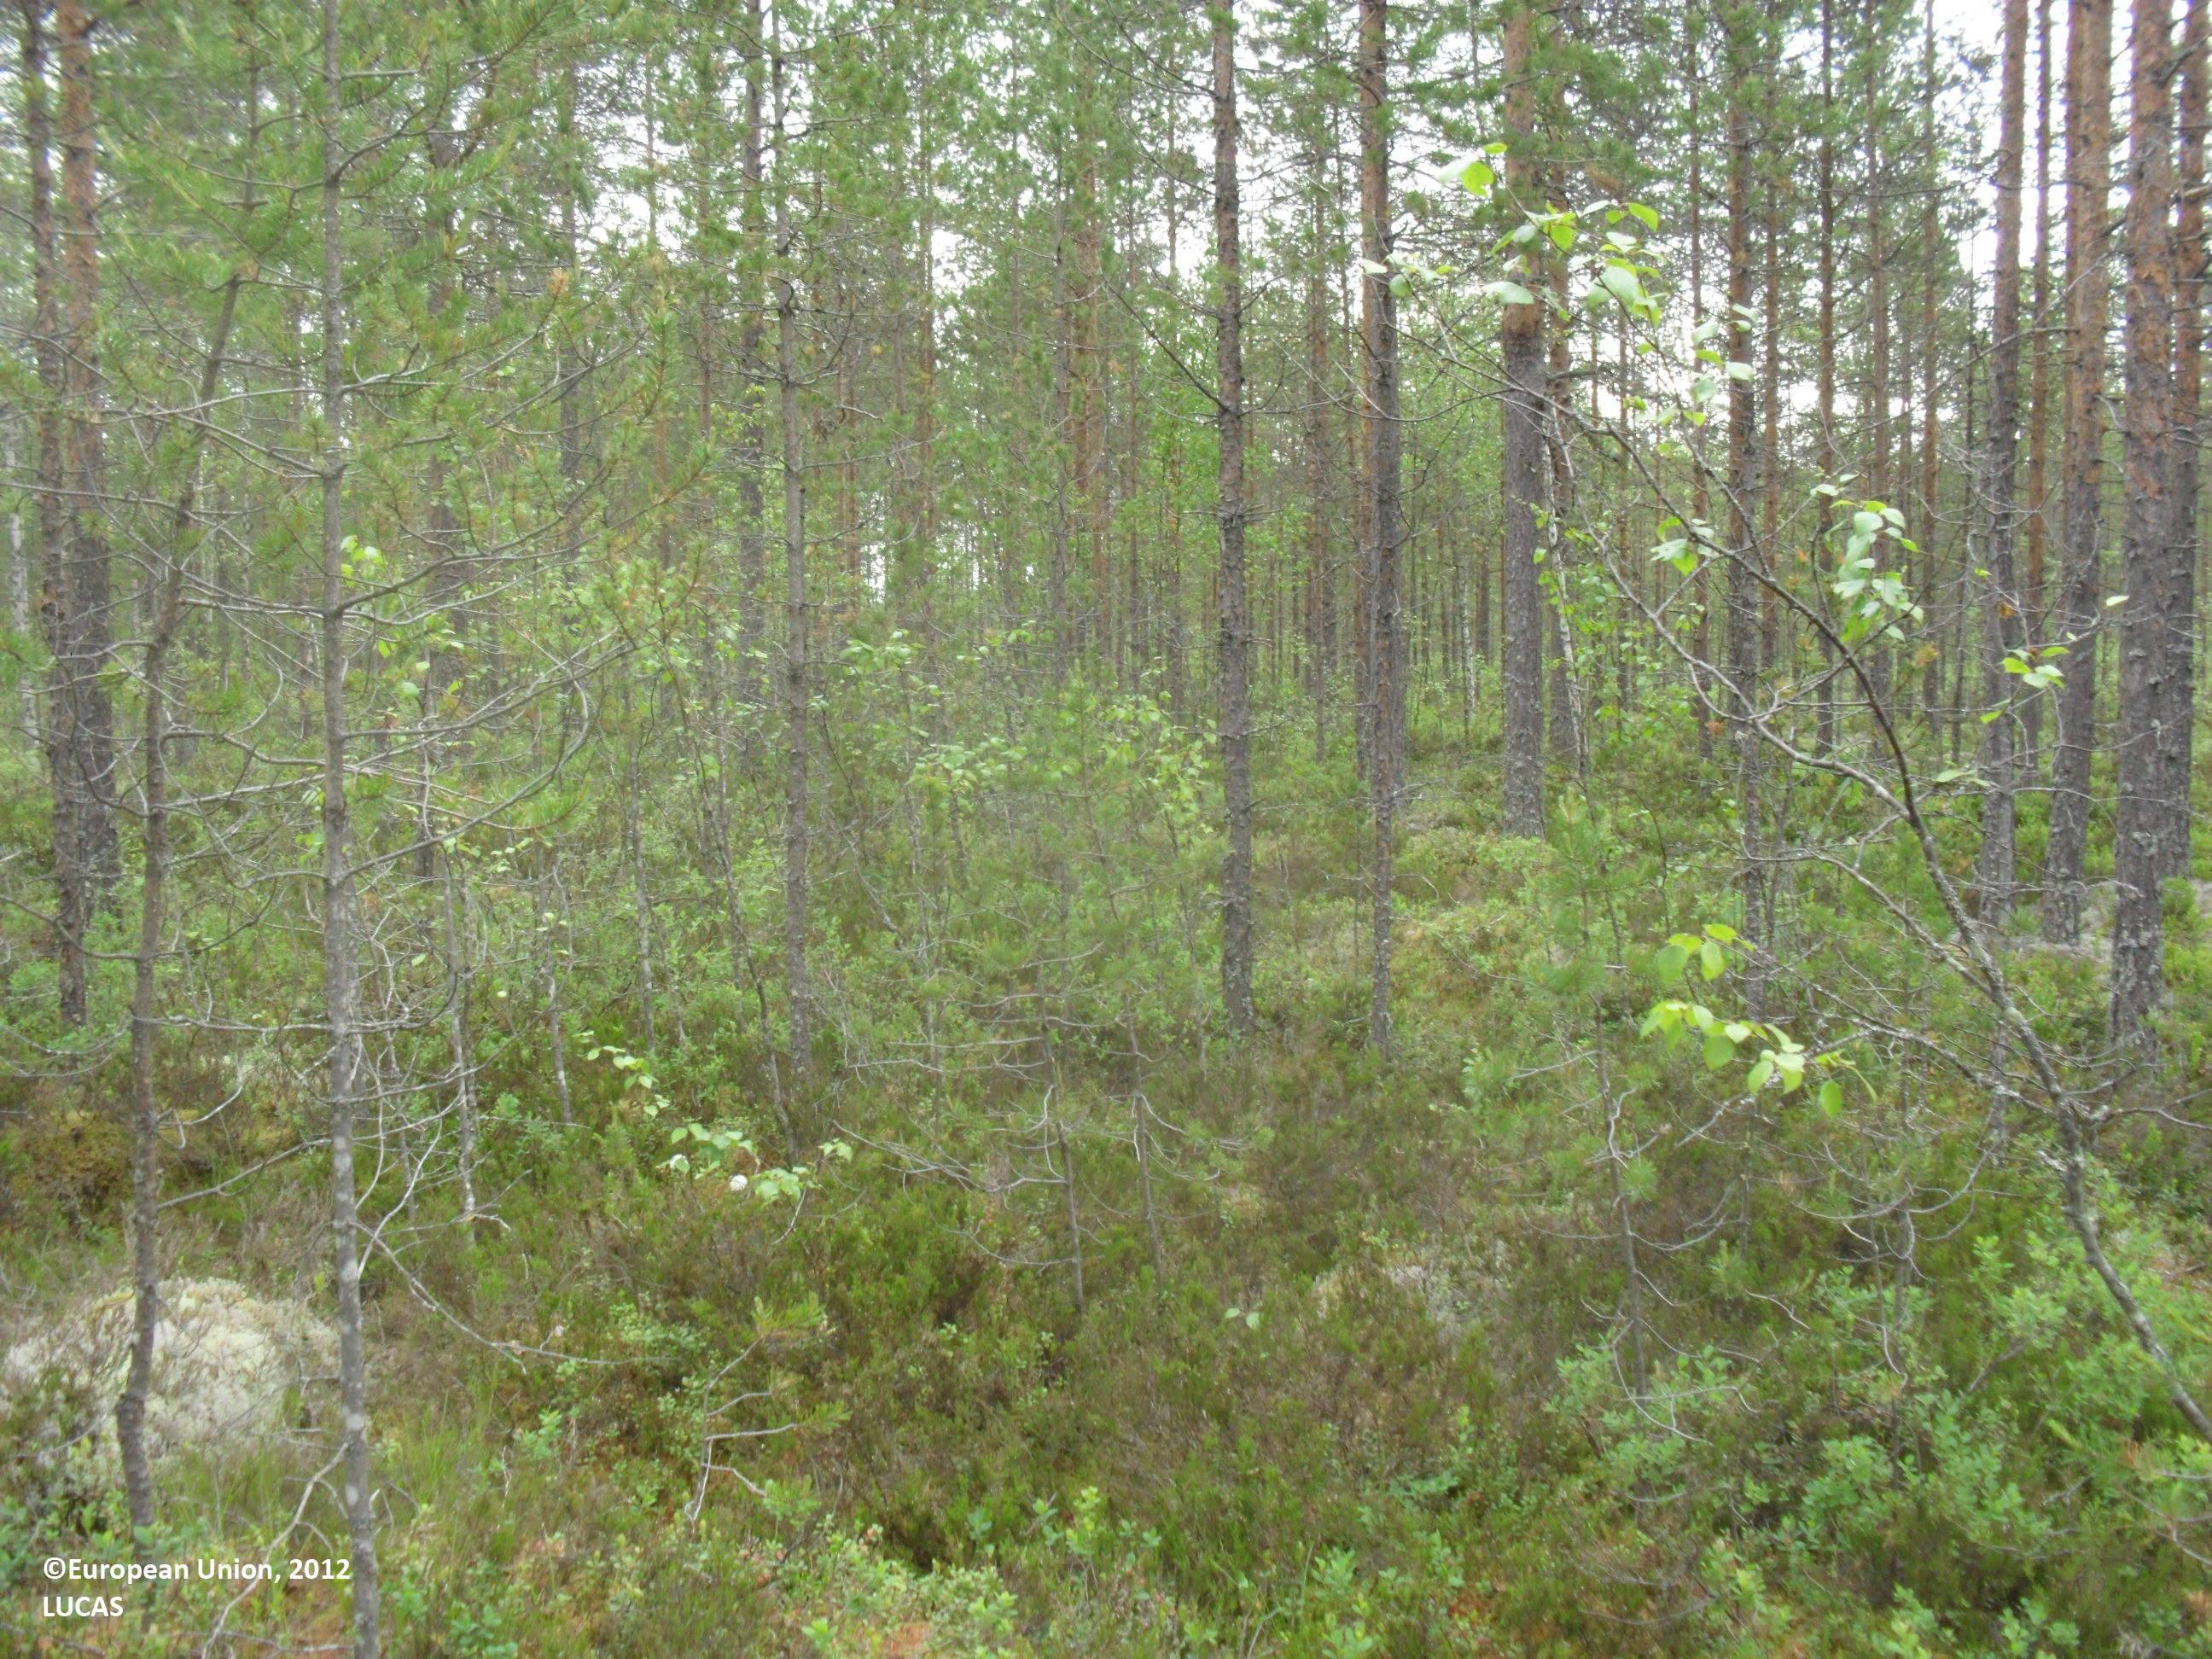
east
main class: Woodland
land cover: Pine dominated coniferous woodland
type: boreal forest
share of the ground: 25 - 50 %
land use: Forestry
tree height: > 5 m
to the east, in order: Pine dominated coniferous woodland; Pine dominated mixed woodland; Tracks; Pine dominated mixed woodland; Spontaneously vegetated surfaces; Other mixed woodland; Electric lines; Other mixed woodland
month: June
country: FI
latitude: 62.8431
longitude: 23.7205
